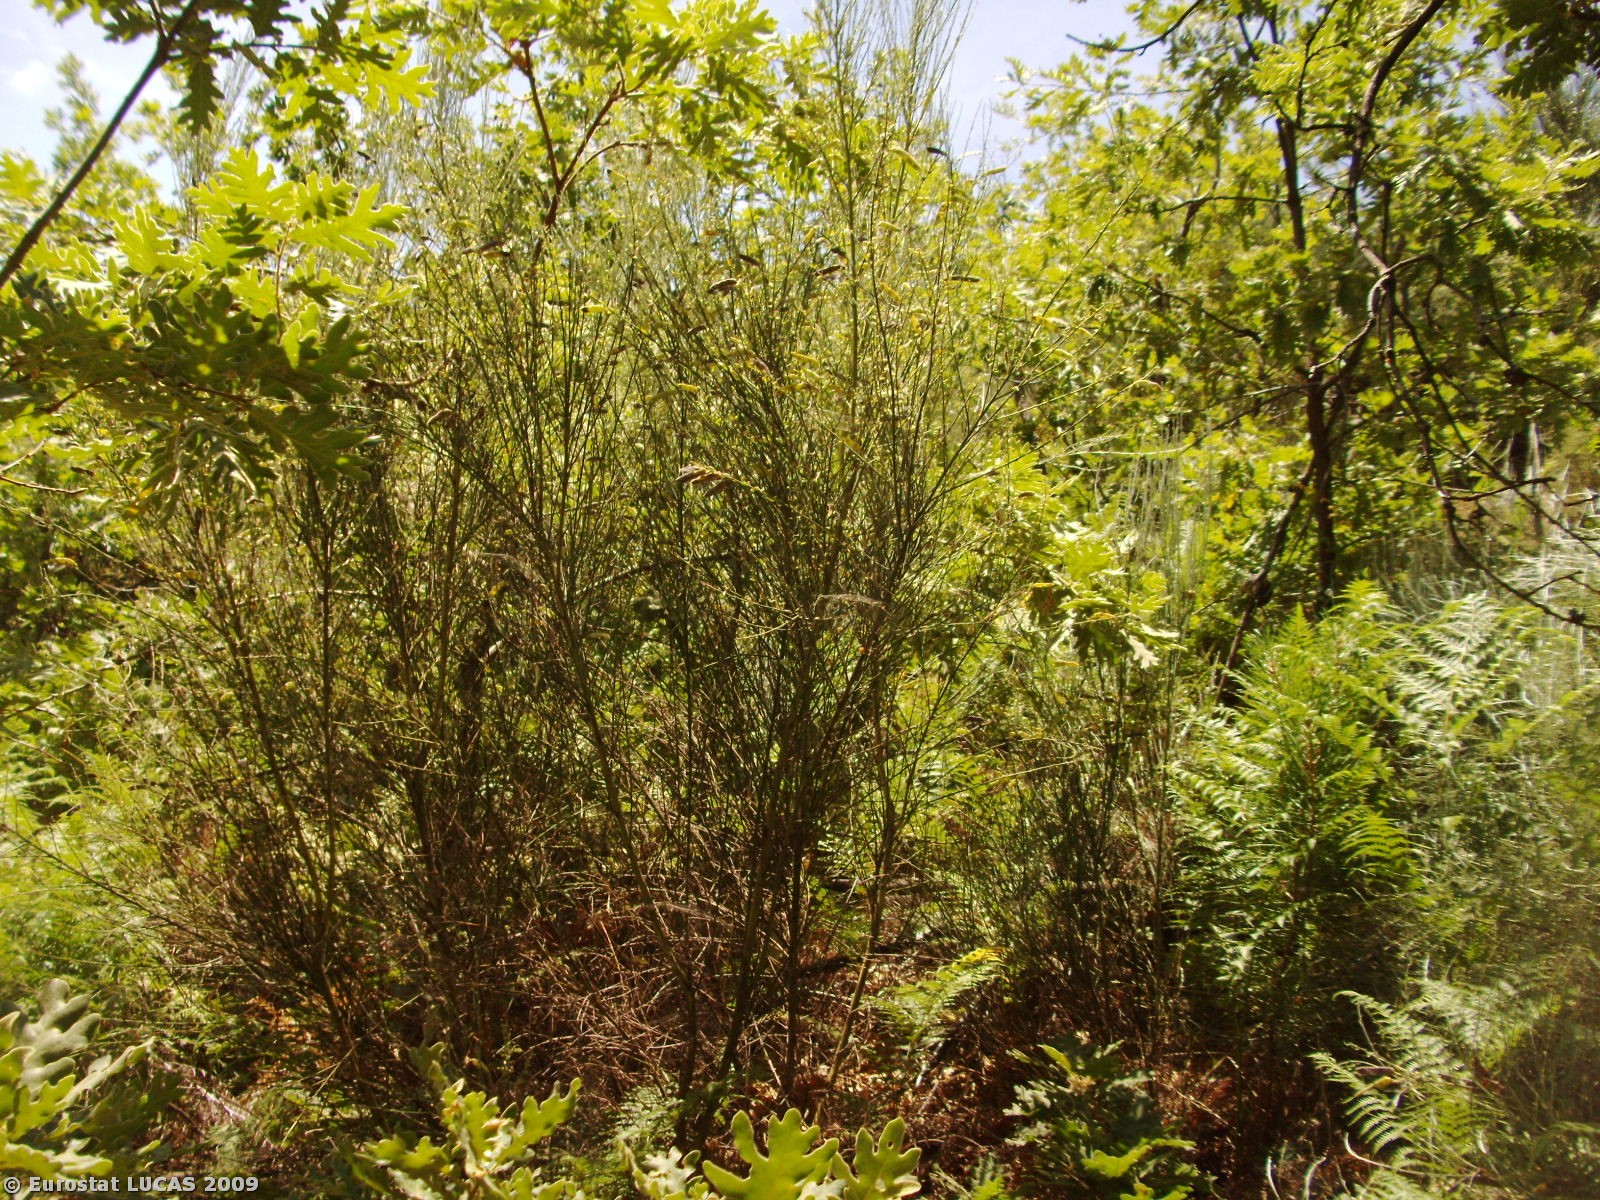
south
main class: Woodland
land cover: Mixed woodland
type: mesophytic deciduous forest
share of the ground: > 75 %
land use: Forestry
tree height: > 5 m
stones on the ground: 25 - 50 %
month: June
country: PT
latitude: 40.1059
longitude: -7.4779
